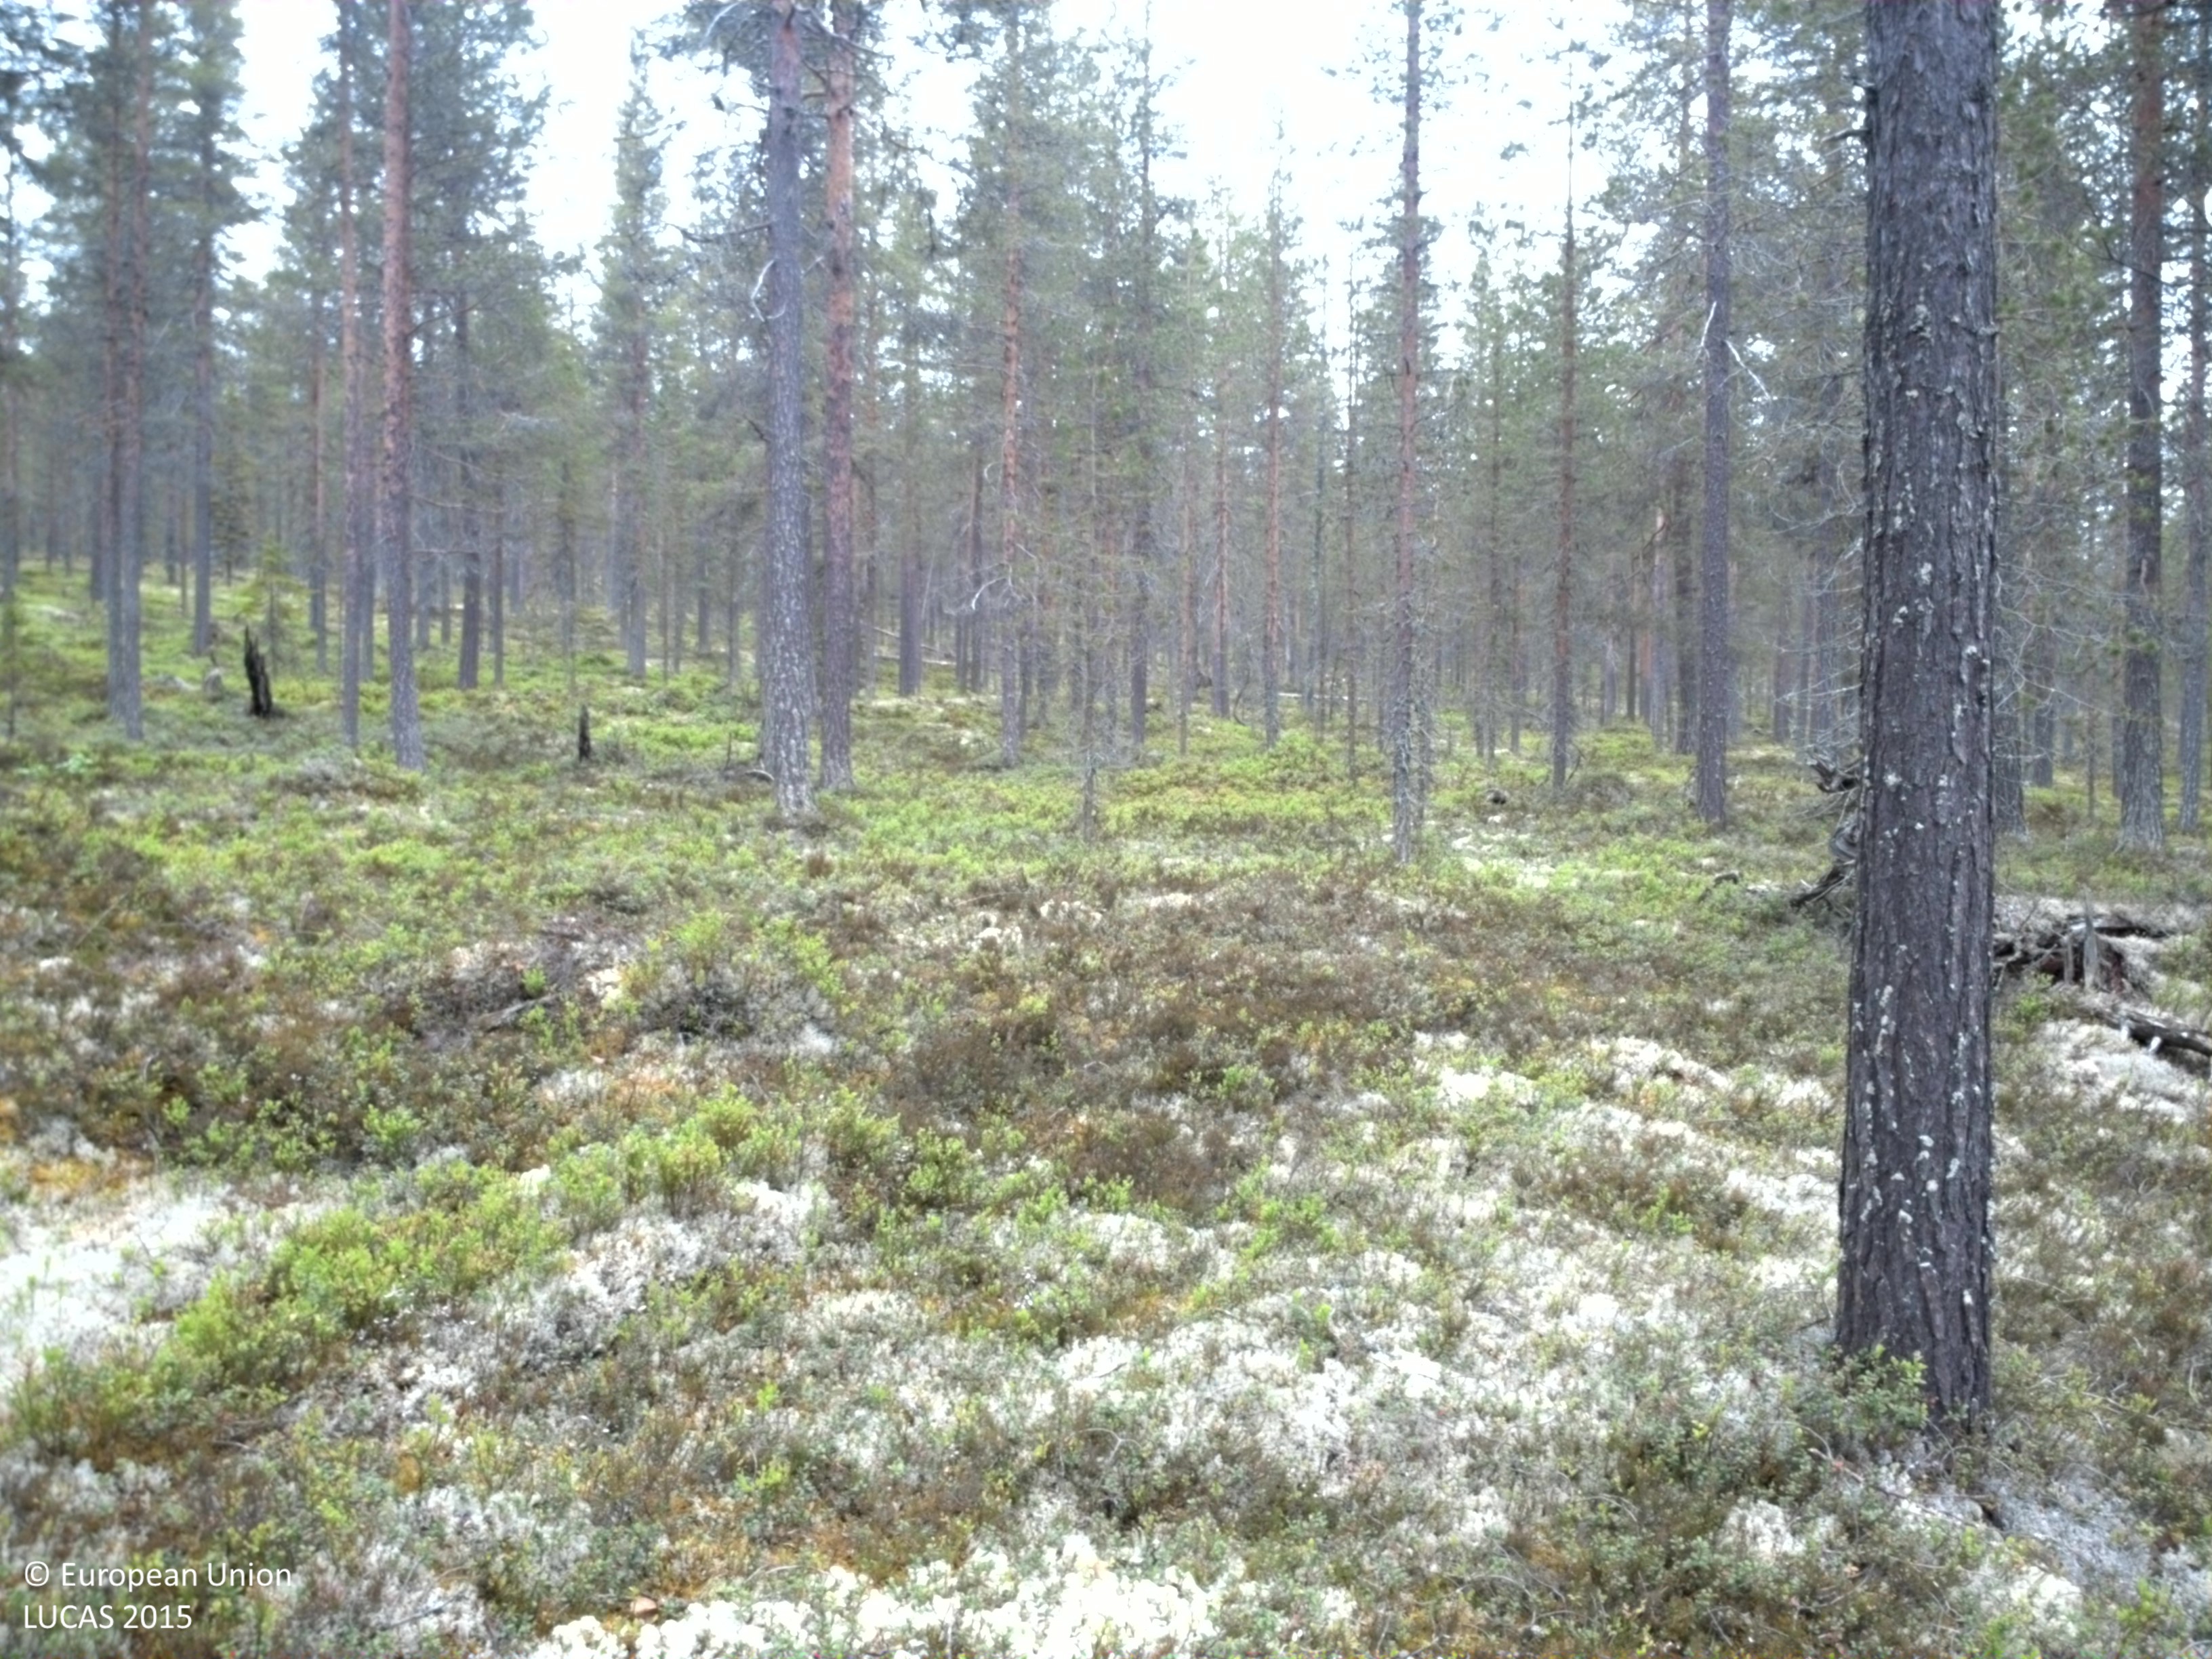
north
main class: Woodland
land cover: Pine dominated coniferous woodland
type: boreal forest
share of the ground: 50 - 75 %
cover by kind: coniferous forest trees 60 %, lichens and mosses 25 %, herbaceous plants 15 %
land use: Forestry
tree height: > 5 m
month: June
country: SE
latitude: 61.4496
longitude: 13.6446
